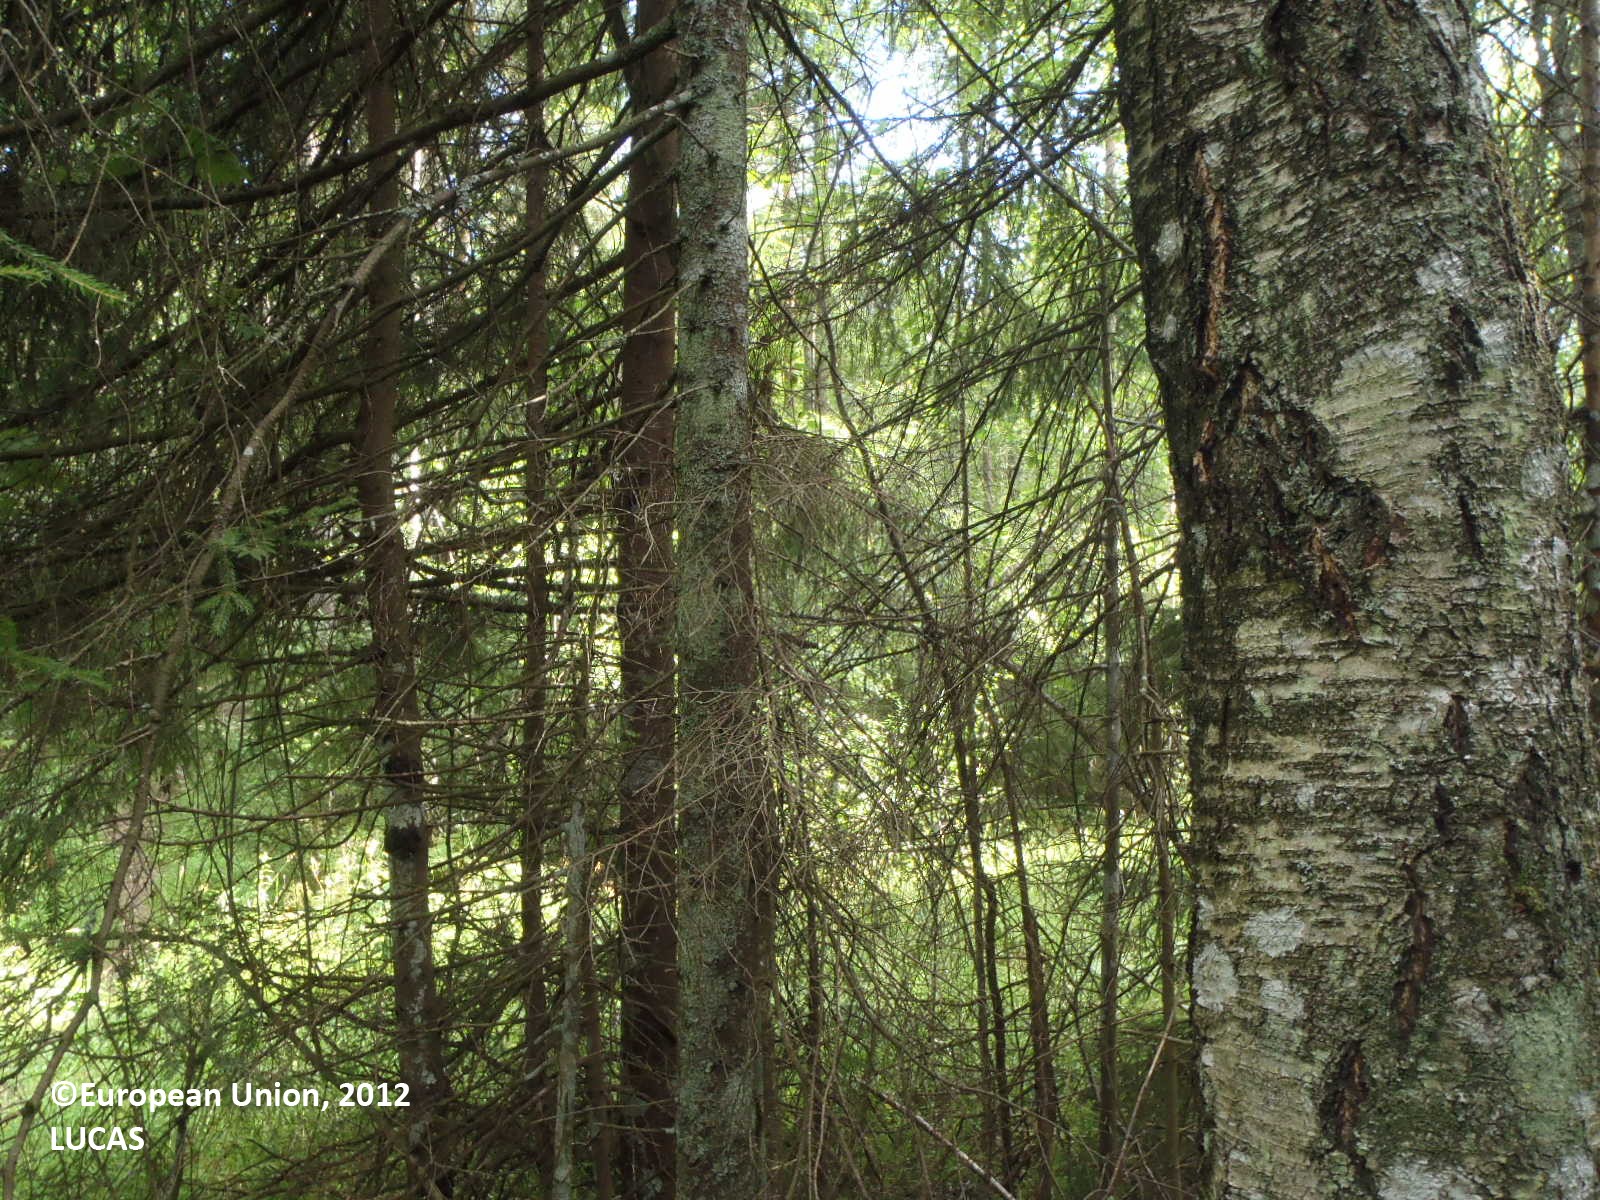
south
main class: Woodland
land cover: Spruce dominated mixed woodland
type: boreal forest
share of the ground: > 75 %
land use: Forestry
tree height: > 5 m
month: August
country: FI
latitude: 60.2955
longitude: 22.3169
